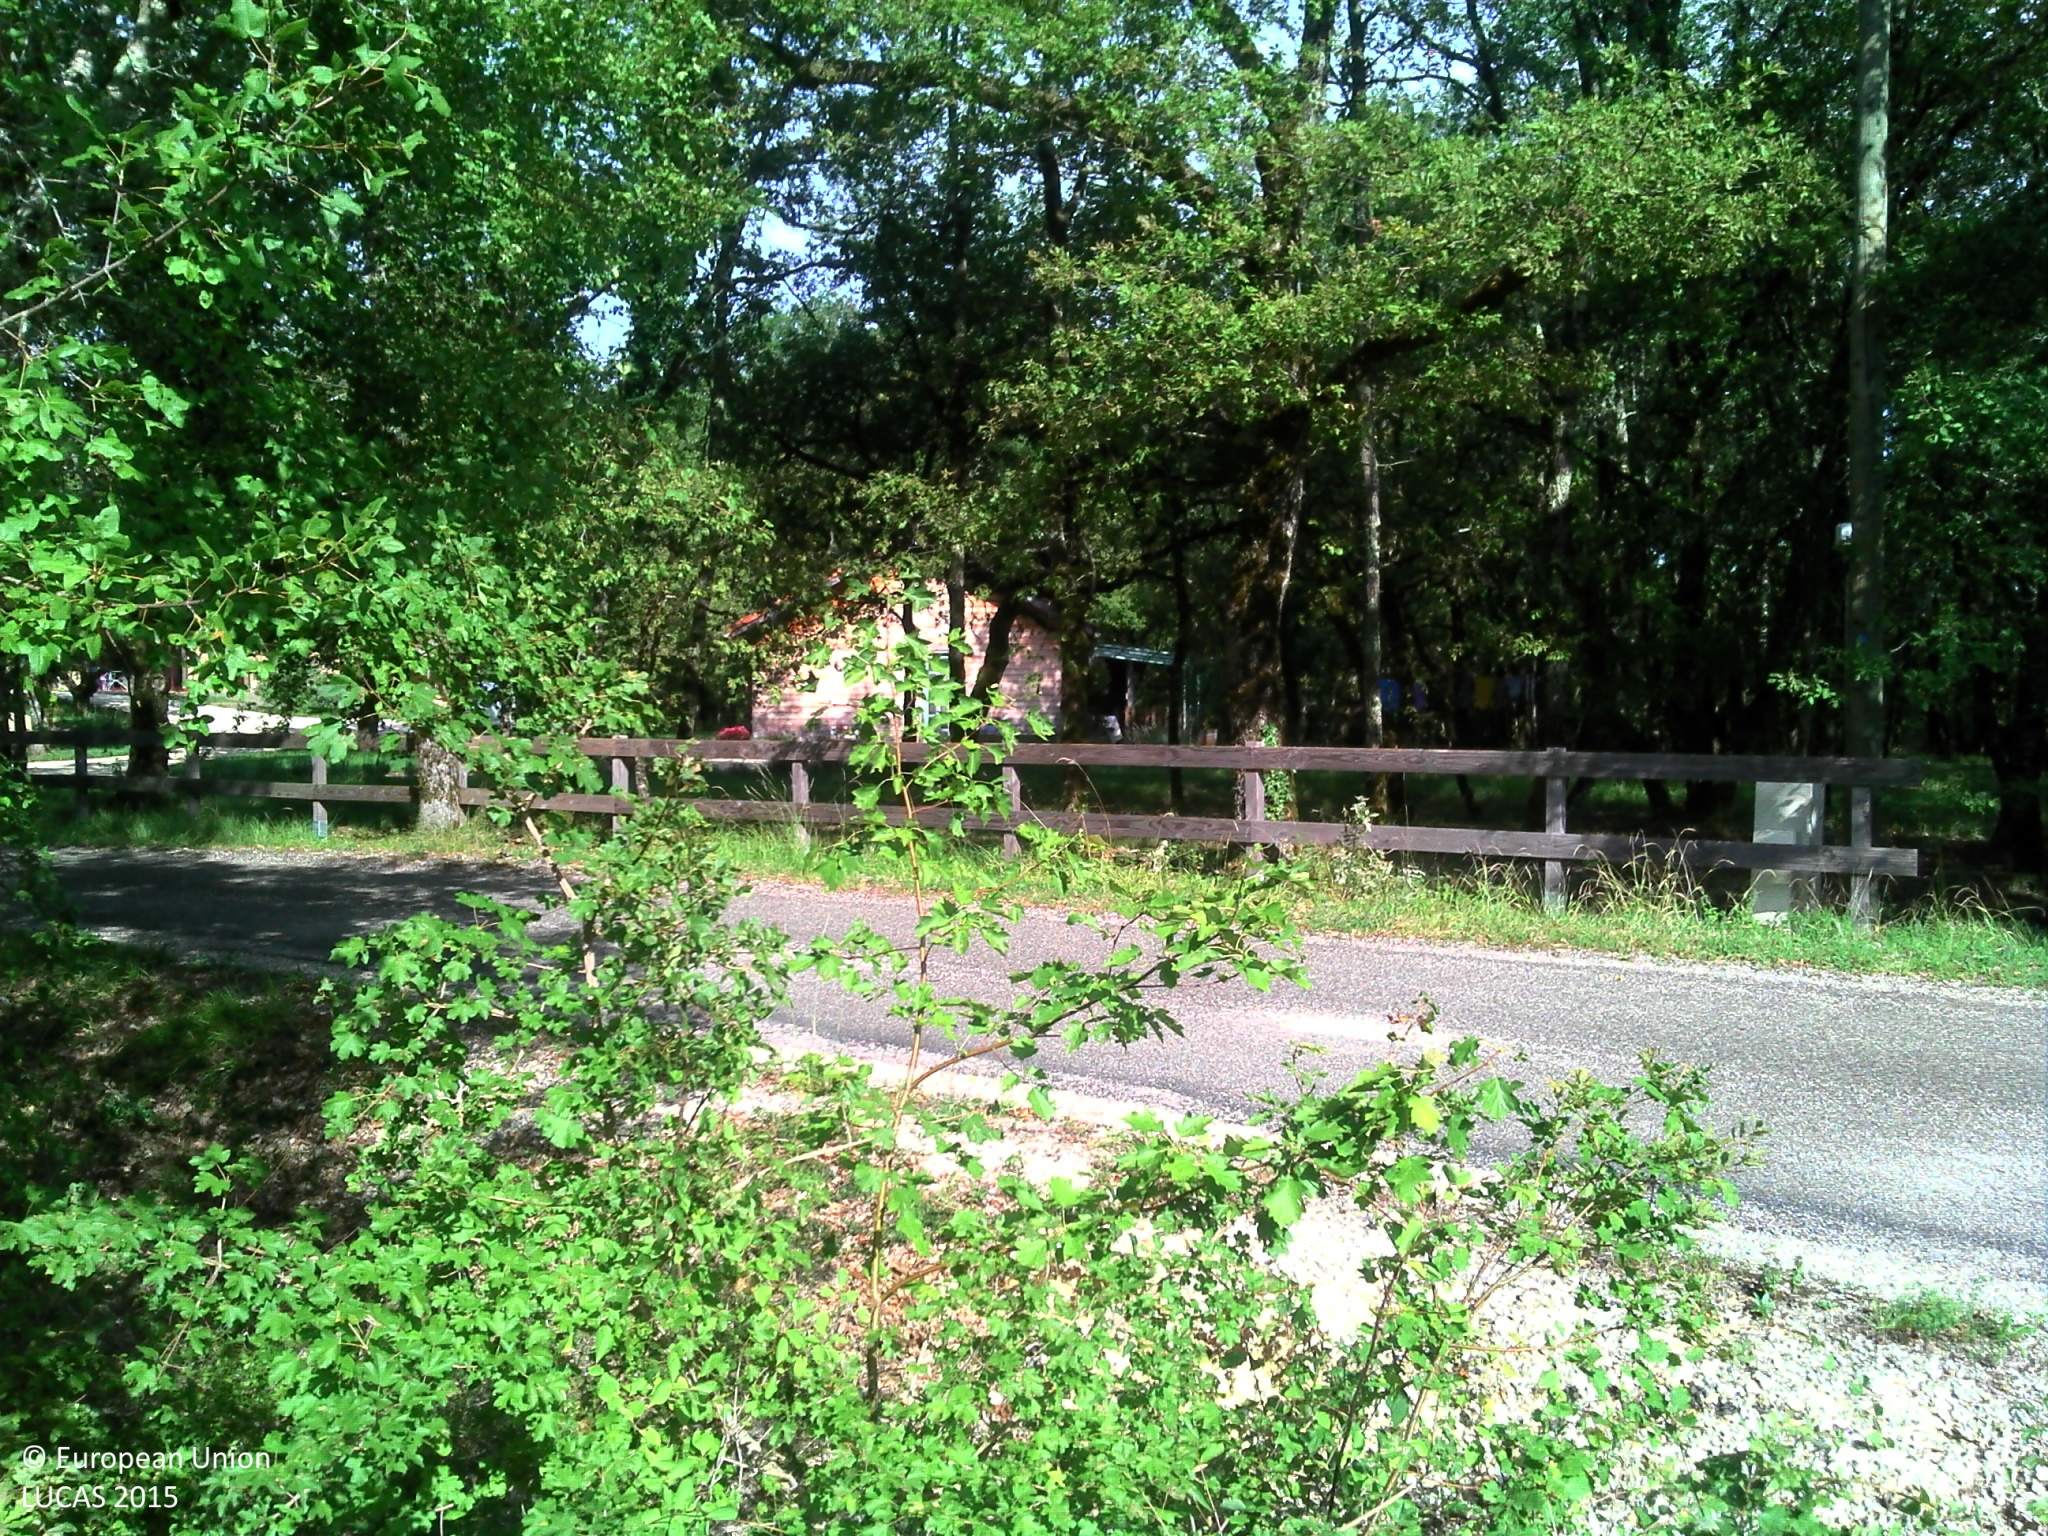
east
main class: Grassland
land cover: Grassland with sparse tree/shrub cover
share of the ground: > 75 %
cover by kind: herbaceous plants 90 %, broadleaved forest trees 5 %, shrubs 5 %
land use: Agriculture (excluding fallow land and kitchen gardens)
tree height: > 5 m
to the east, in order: Grassland with sparse tree/shrub cover; Ditches and canals; Grass margins; Paved roads, cycling and walking lanes; Grass margins; Fences; Broadleaved woodland; Artificial constructions in urban areas; Broadleaved woodland; Dry stone walls; Broadleaved woodland; Dry stone walls; Broadleaved woodland; Dry stone walls; Broadleaved woodland; Dry stone walls; Fences; Broadleaved woodland
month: August
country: FR
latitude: 44.5087
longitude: 1.2799
